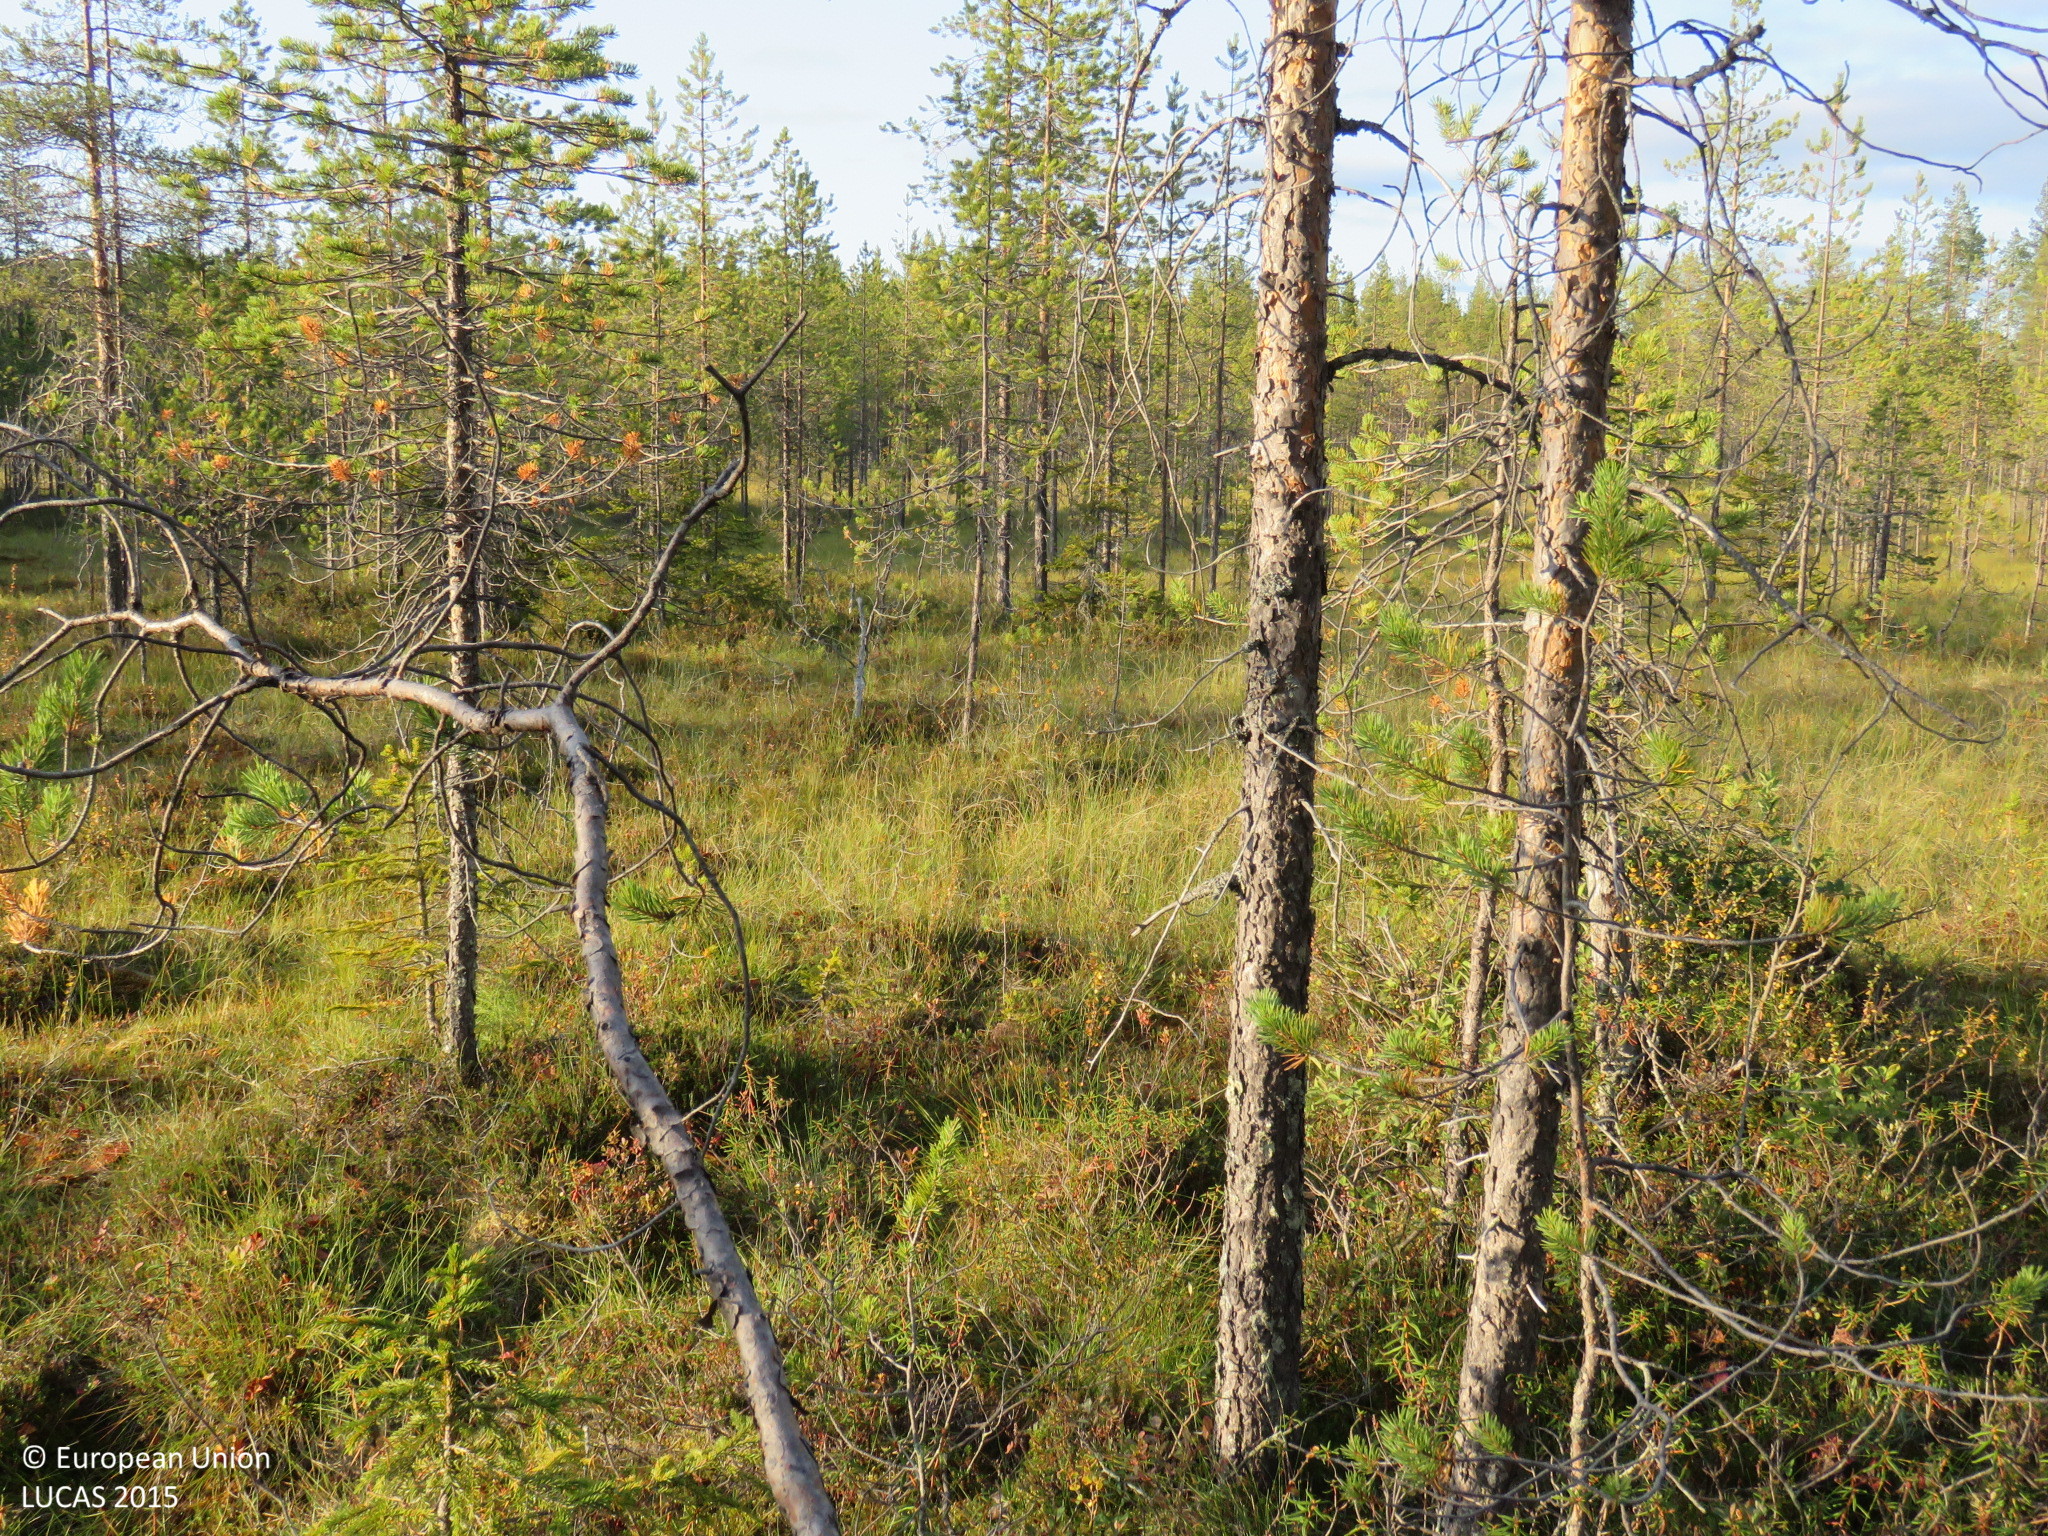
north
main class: Woodland
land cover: Pine dominated coniferous woodland
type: mire and swamp forests
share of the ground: 25 - 50 %
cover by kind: coniferous forest trees 45 %, herbaceous plants 25 %, shrubs 20 %, lichens and mosses 10 %
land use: Forestry
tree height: > 5 m
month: September
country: FI
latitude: 65.4957
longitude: 27.7026
